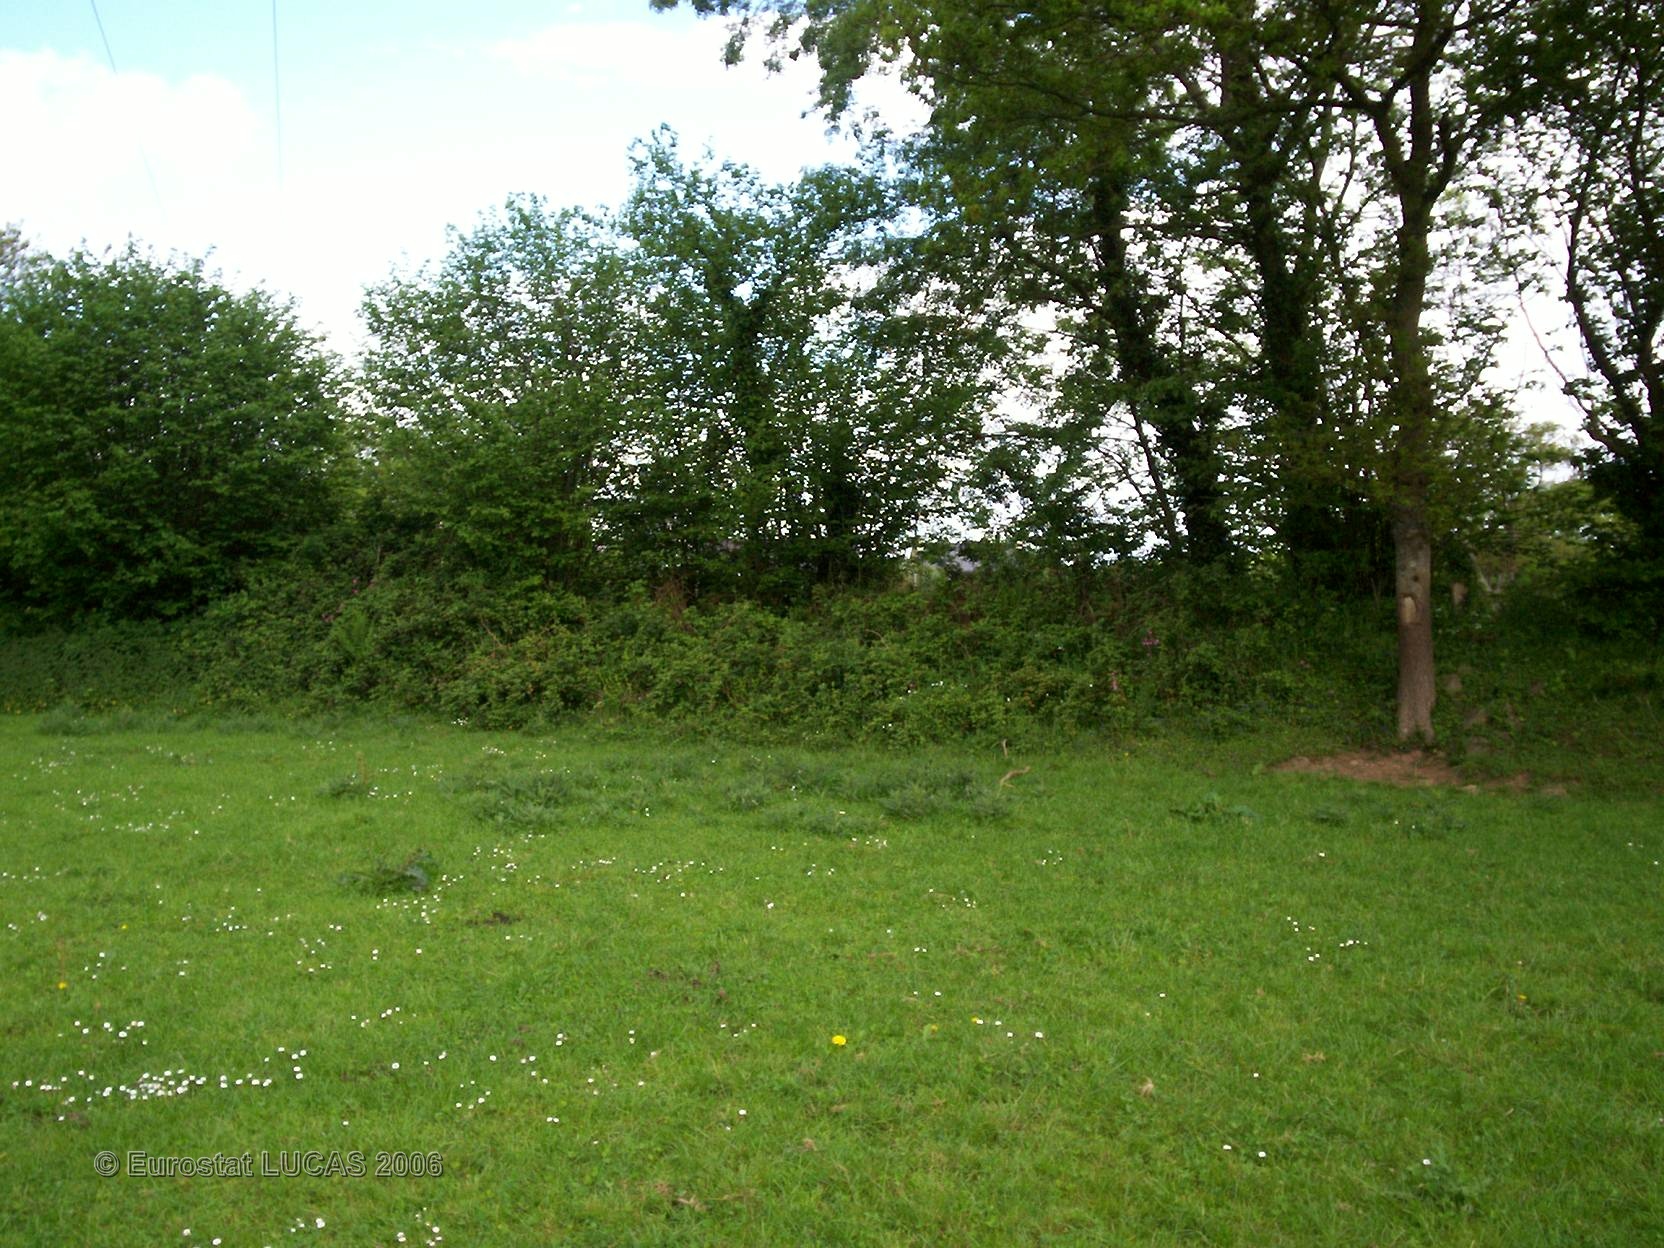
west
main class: Grassland
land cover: Grassland without tree/shrub cover
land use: Agriculture (excluding fallow land and kitchen gardens)
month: May
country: FR
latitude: 48.5749
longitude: -3.7875
